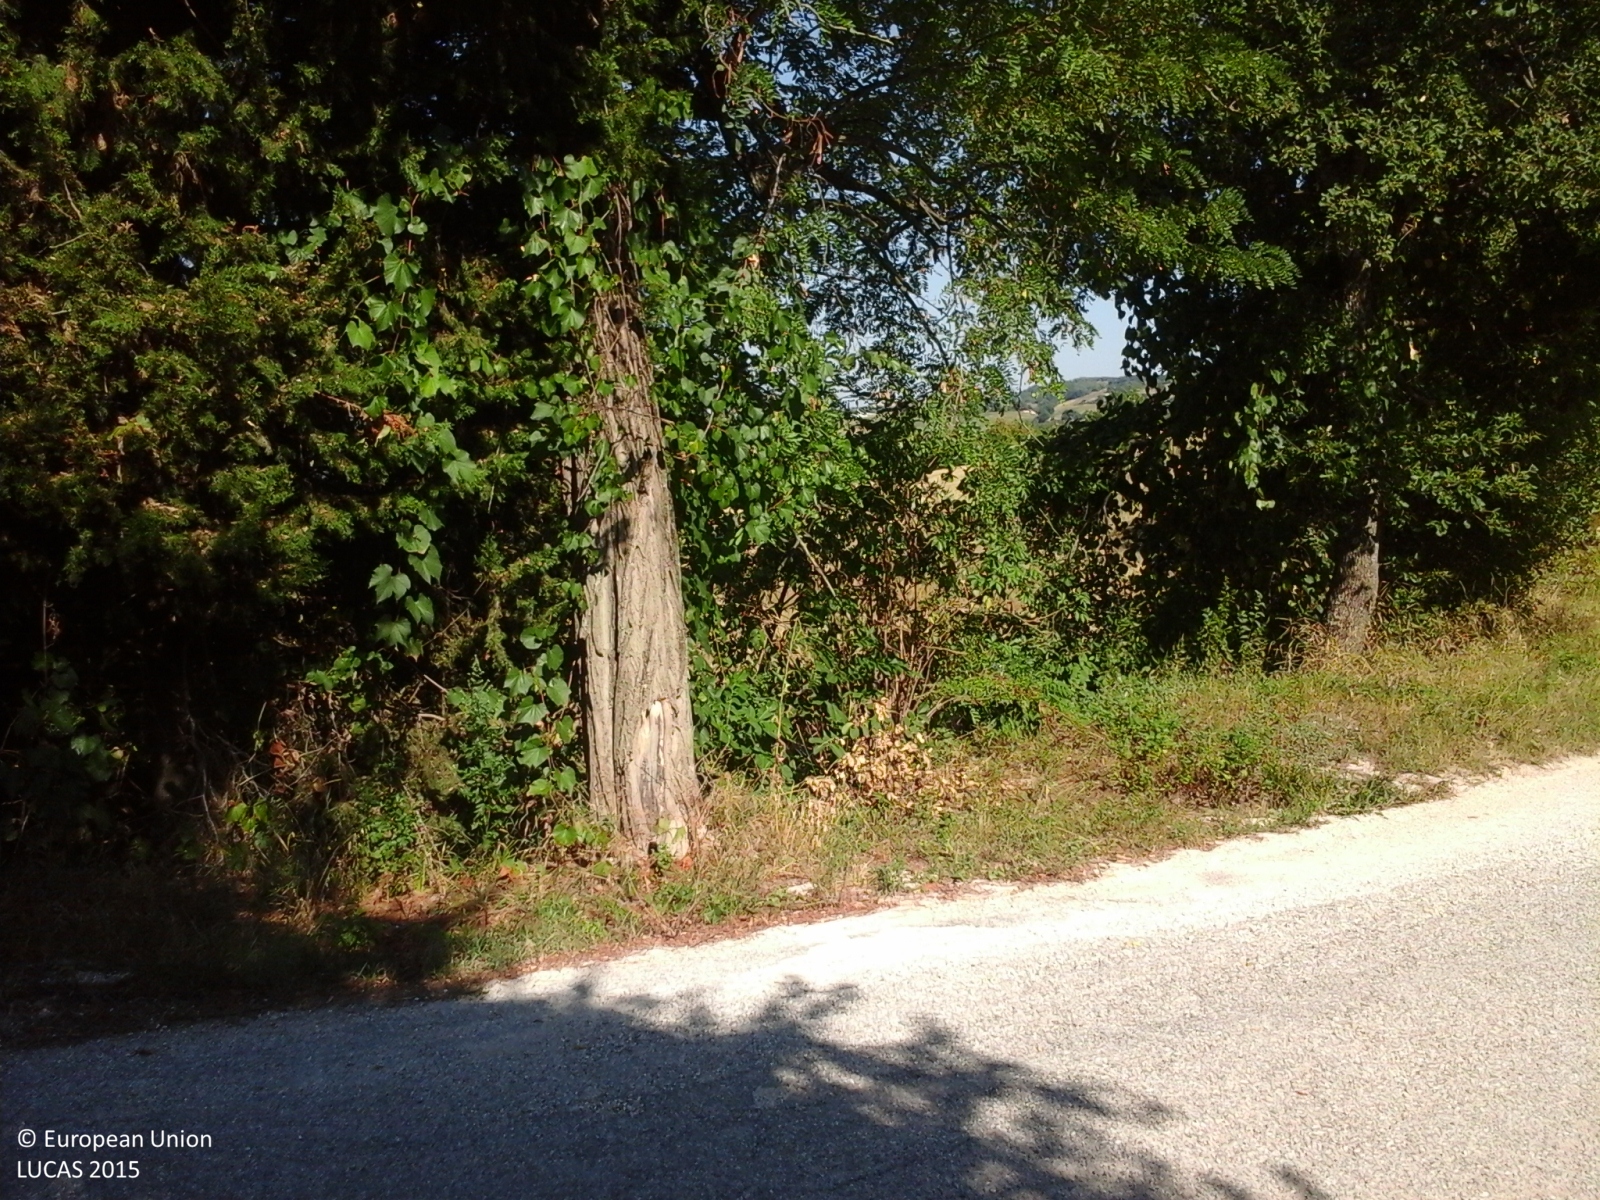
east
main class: Shrubland
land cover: Shrubland with sparse tree cover
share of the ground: > 75 %
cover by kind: shrubs 95 %, broadleaved forest trees 5 %
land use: Semi-natural and natural areas not in use
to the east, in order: Shrubland with sparse tree cover; Paved roads, cycling and walking lanes; Broadleaved woodland; Lucerne; Broadleaved woodland
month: August
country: IT
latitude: 43.7388
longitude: 12.6630
